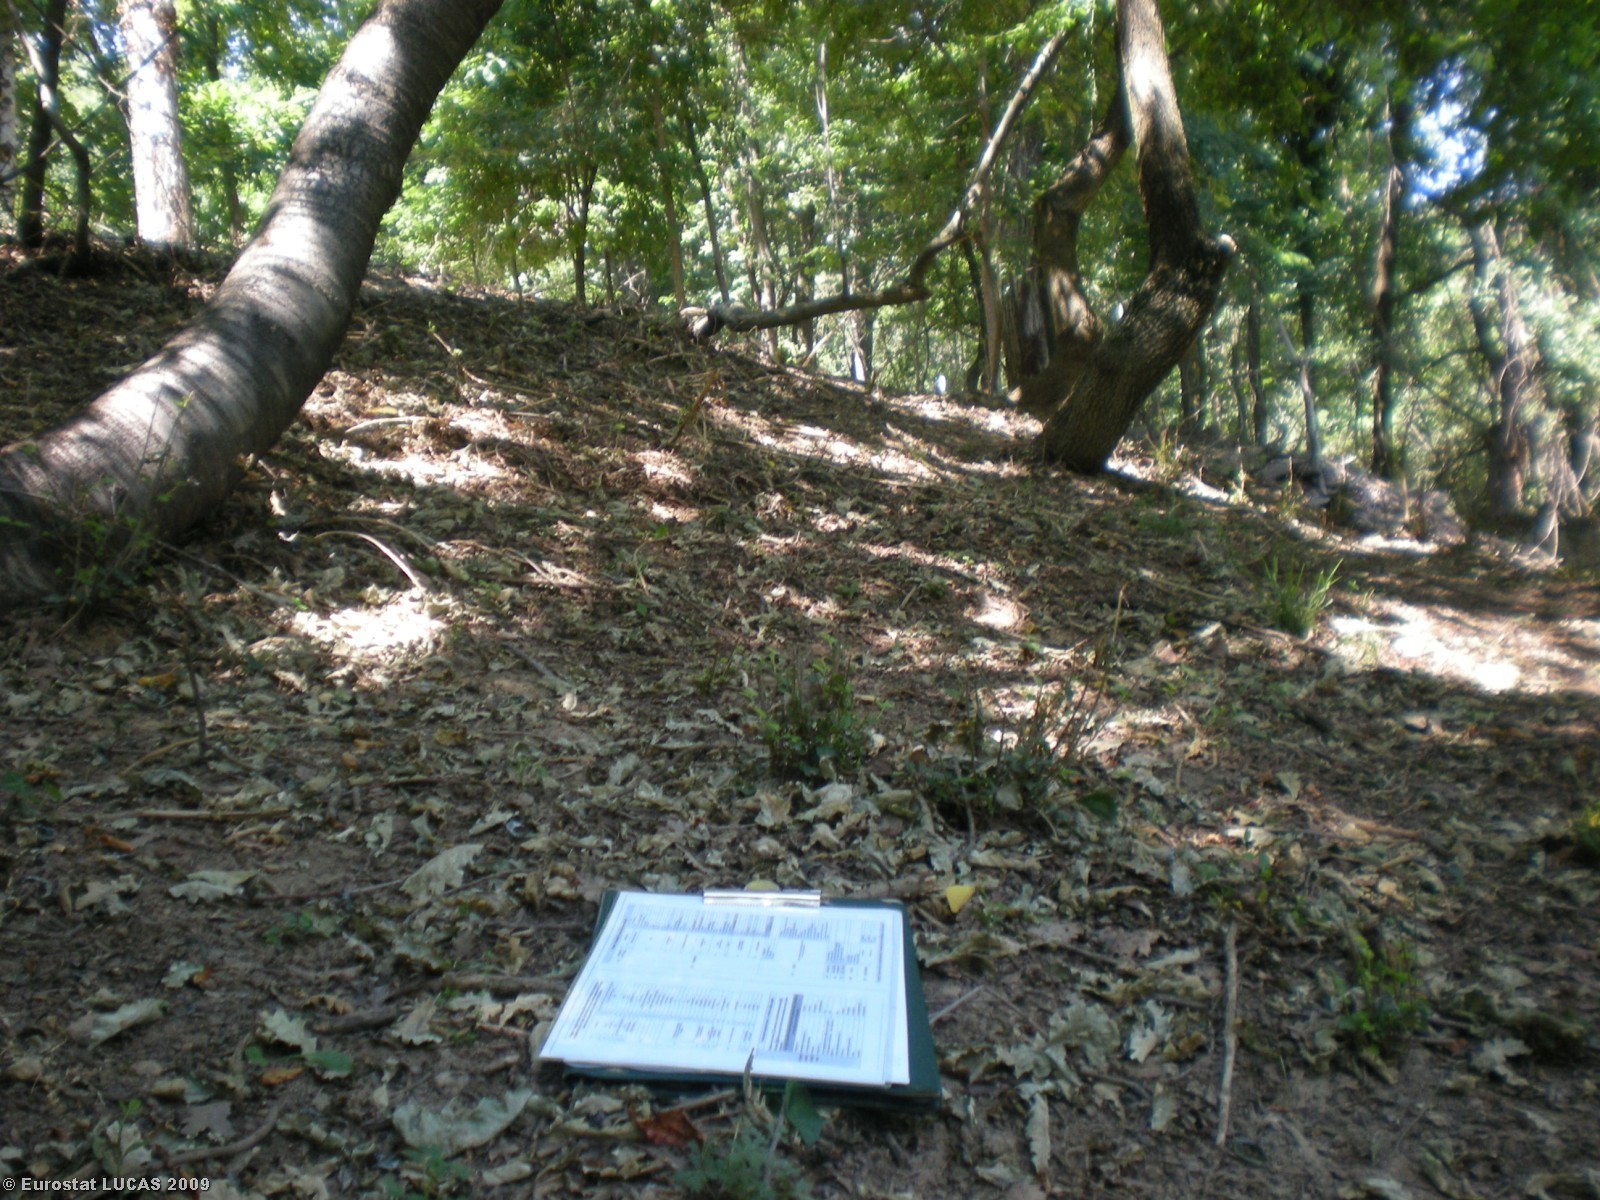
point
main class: Woodland
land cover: Broadleaved woodland
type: mesophytic deciduous forest
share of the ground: > 75 %
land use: Forestry
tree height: > 5 m
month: June
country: IT
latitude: 44.4991
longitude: 7.4270
